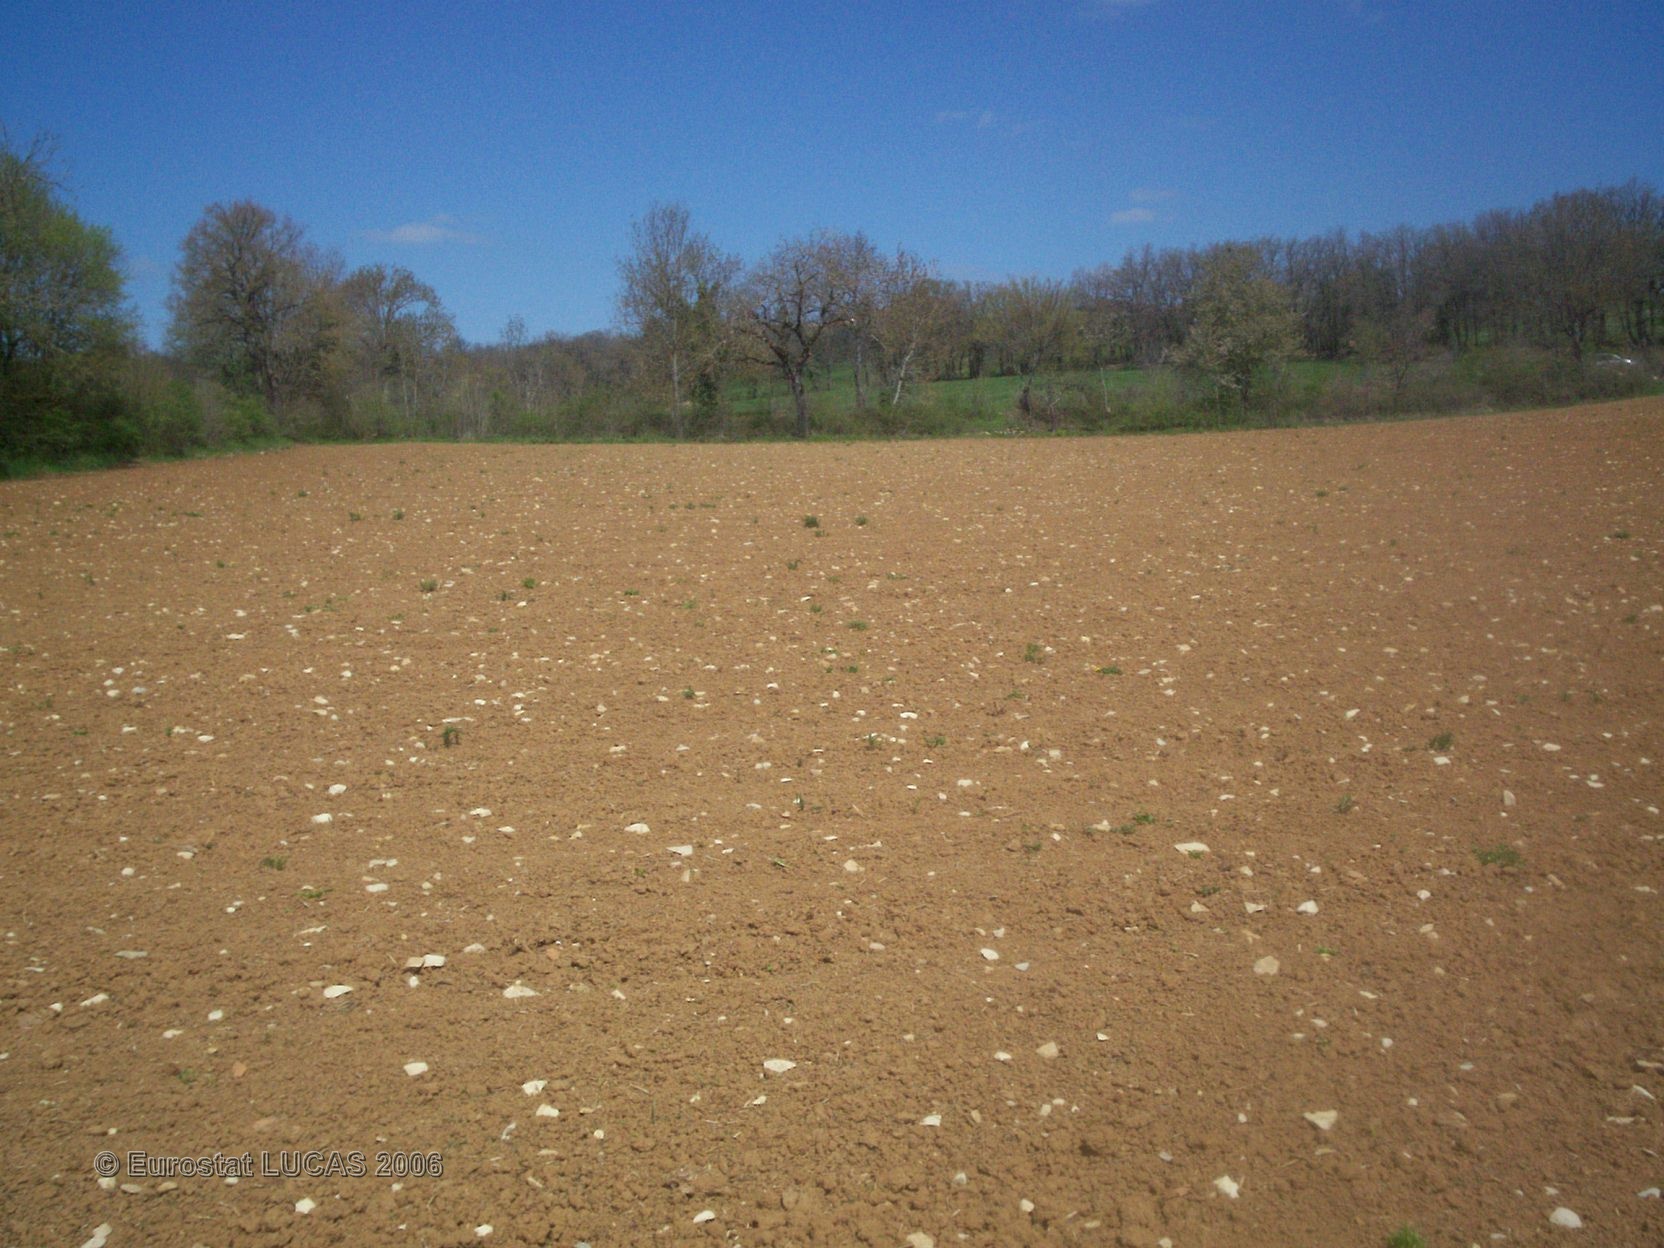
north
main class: Cropland
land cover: Clovers
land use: Agriculture (excluding fallow land and kitchen gardens)
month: May
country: FR
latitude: 44.3264
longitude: 1.9380
